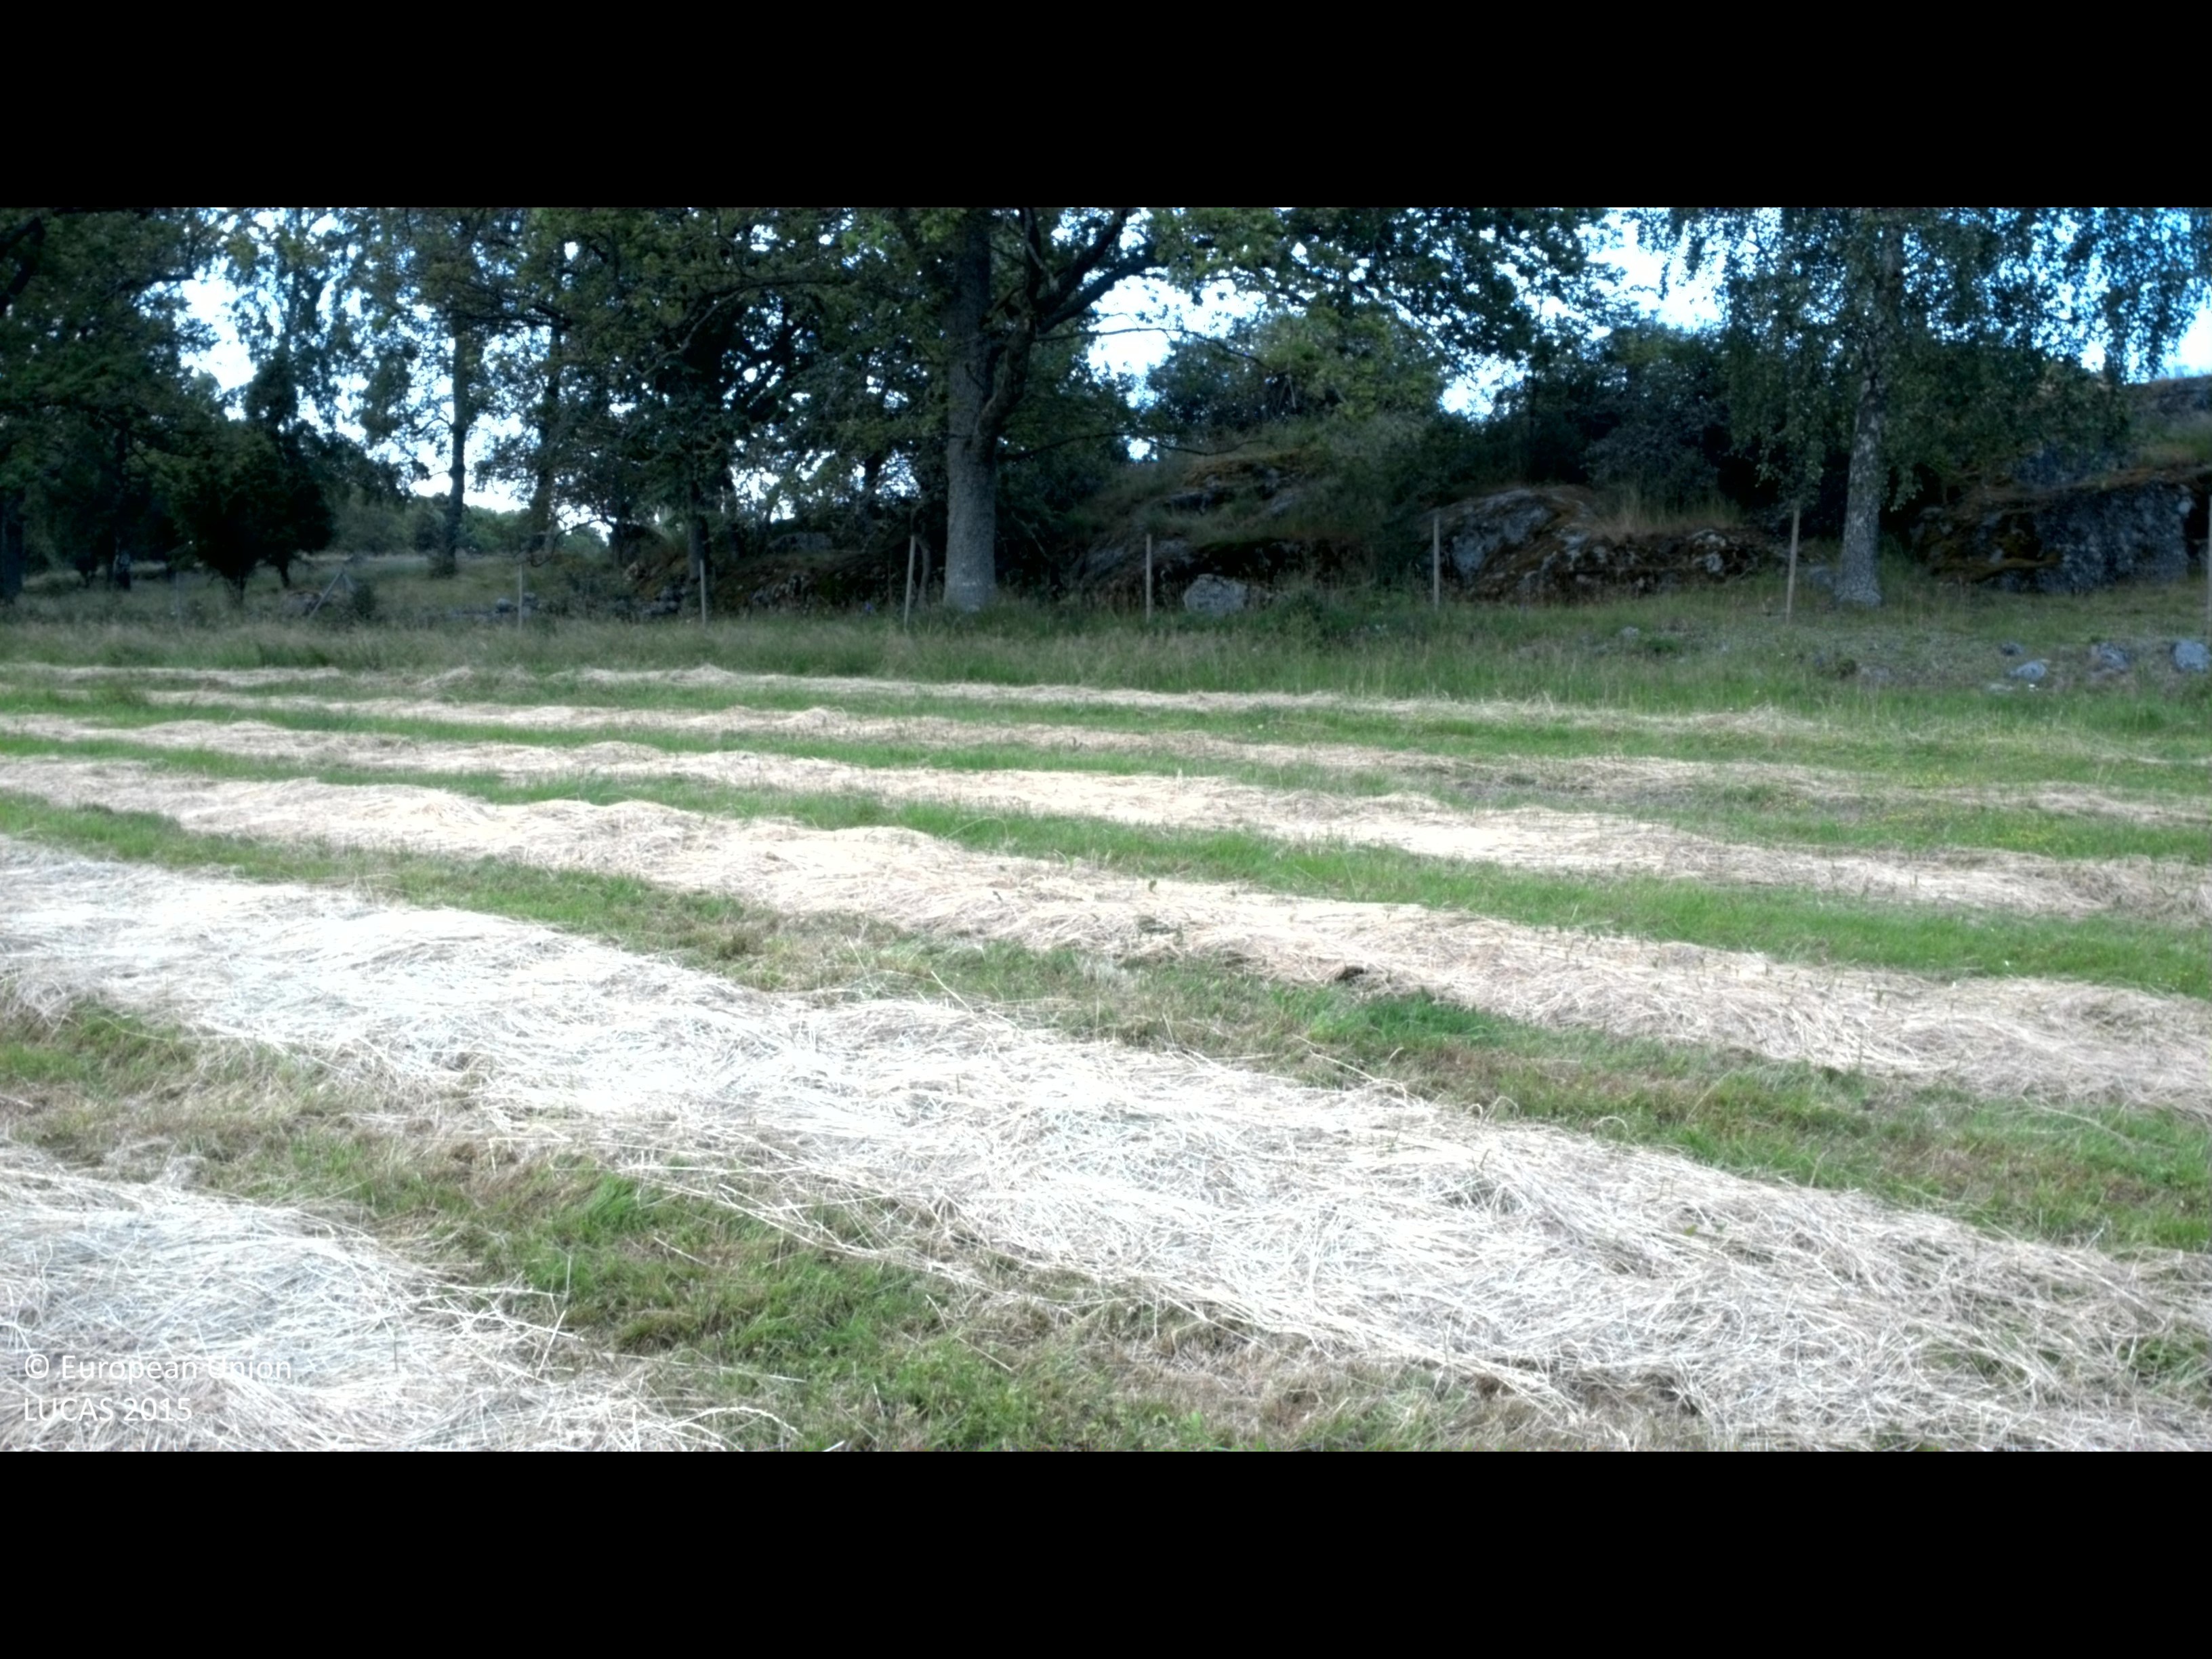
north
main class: Cropland
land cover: Other leguminous and mixtures for fodder
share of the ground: > 75 %
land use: Agriculture (excluding fallow land and kitchen gardens)
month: July
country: SE
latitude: 58.4158
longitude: 16.6558
